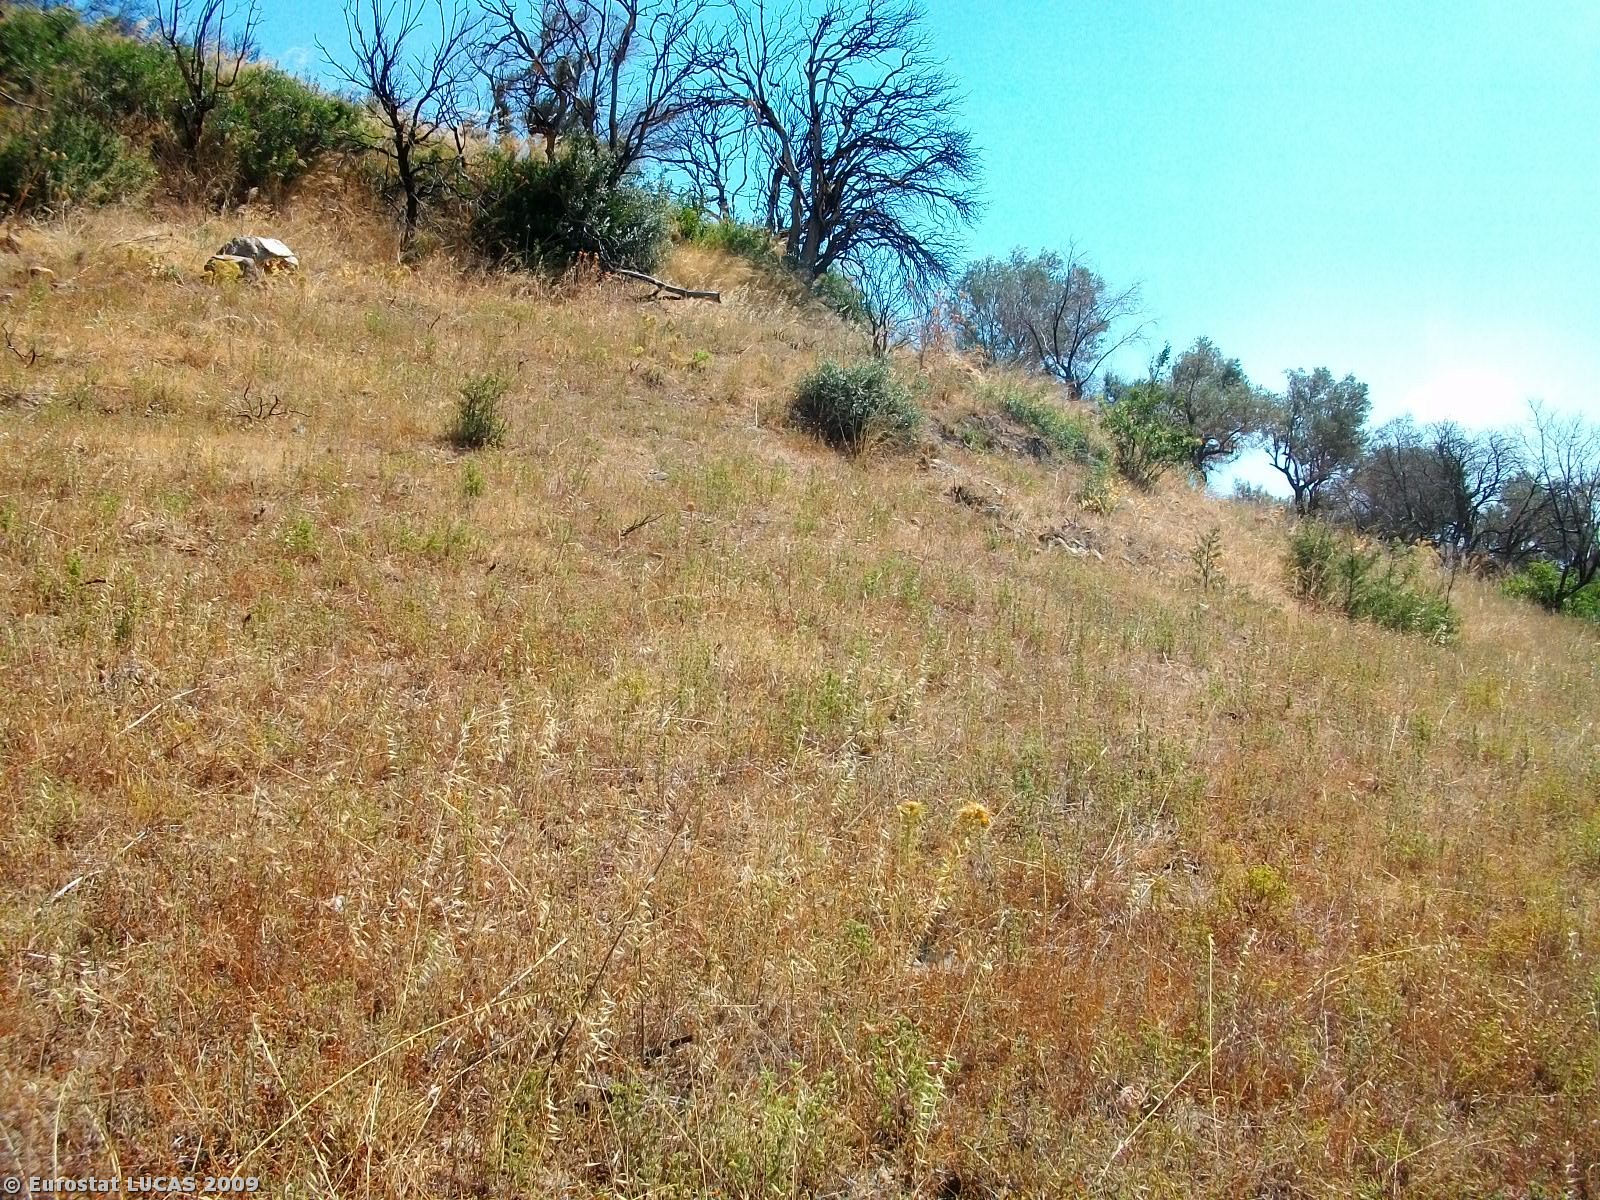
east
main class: Grassland
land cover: Grassland with sparse tree/shrub cover
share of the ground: > 75 %
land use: Unused
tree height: < 5 m
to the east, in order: Grassland with sparse tree/shrub cover; Single bushes/trees; Paved roads, cycling and walking lanes; Grassland with sparse tree/shrub cover; Single bushes/trees; Grassland with sparse tree/shrub cover; Shrubland with sparse tree cover; Grassland with sparse tree/shrub cover; Single bushes/trees; Grassland with sparse tree/shrub cover; Abandoned hedges; Grassland with sparse tree/shrub cover; Abandoned hedges; Grassland with sparse tree/shrub cover; Single bushes/trees; Grassland with sparse tree/shrub cover; Abandoned hedges; Grassland with sparse tree/shrub cover
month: August
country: GR
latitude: 38.4925
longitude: 23.9668
